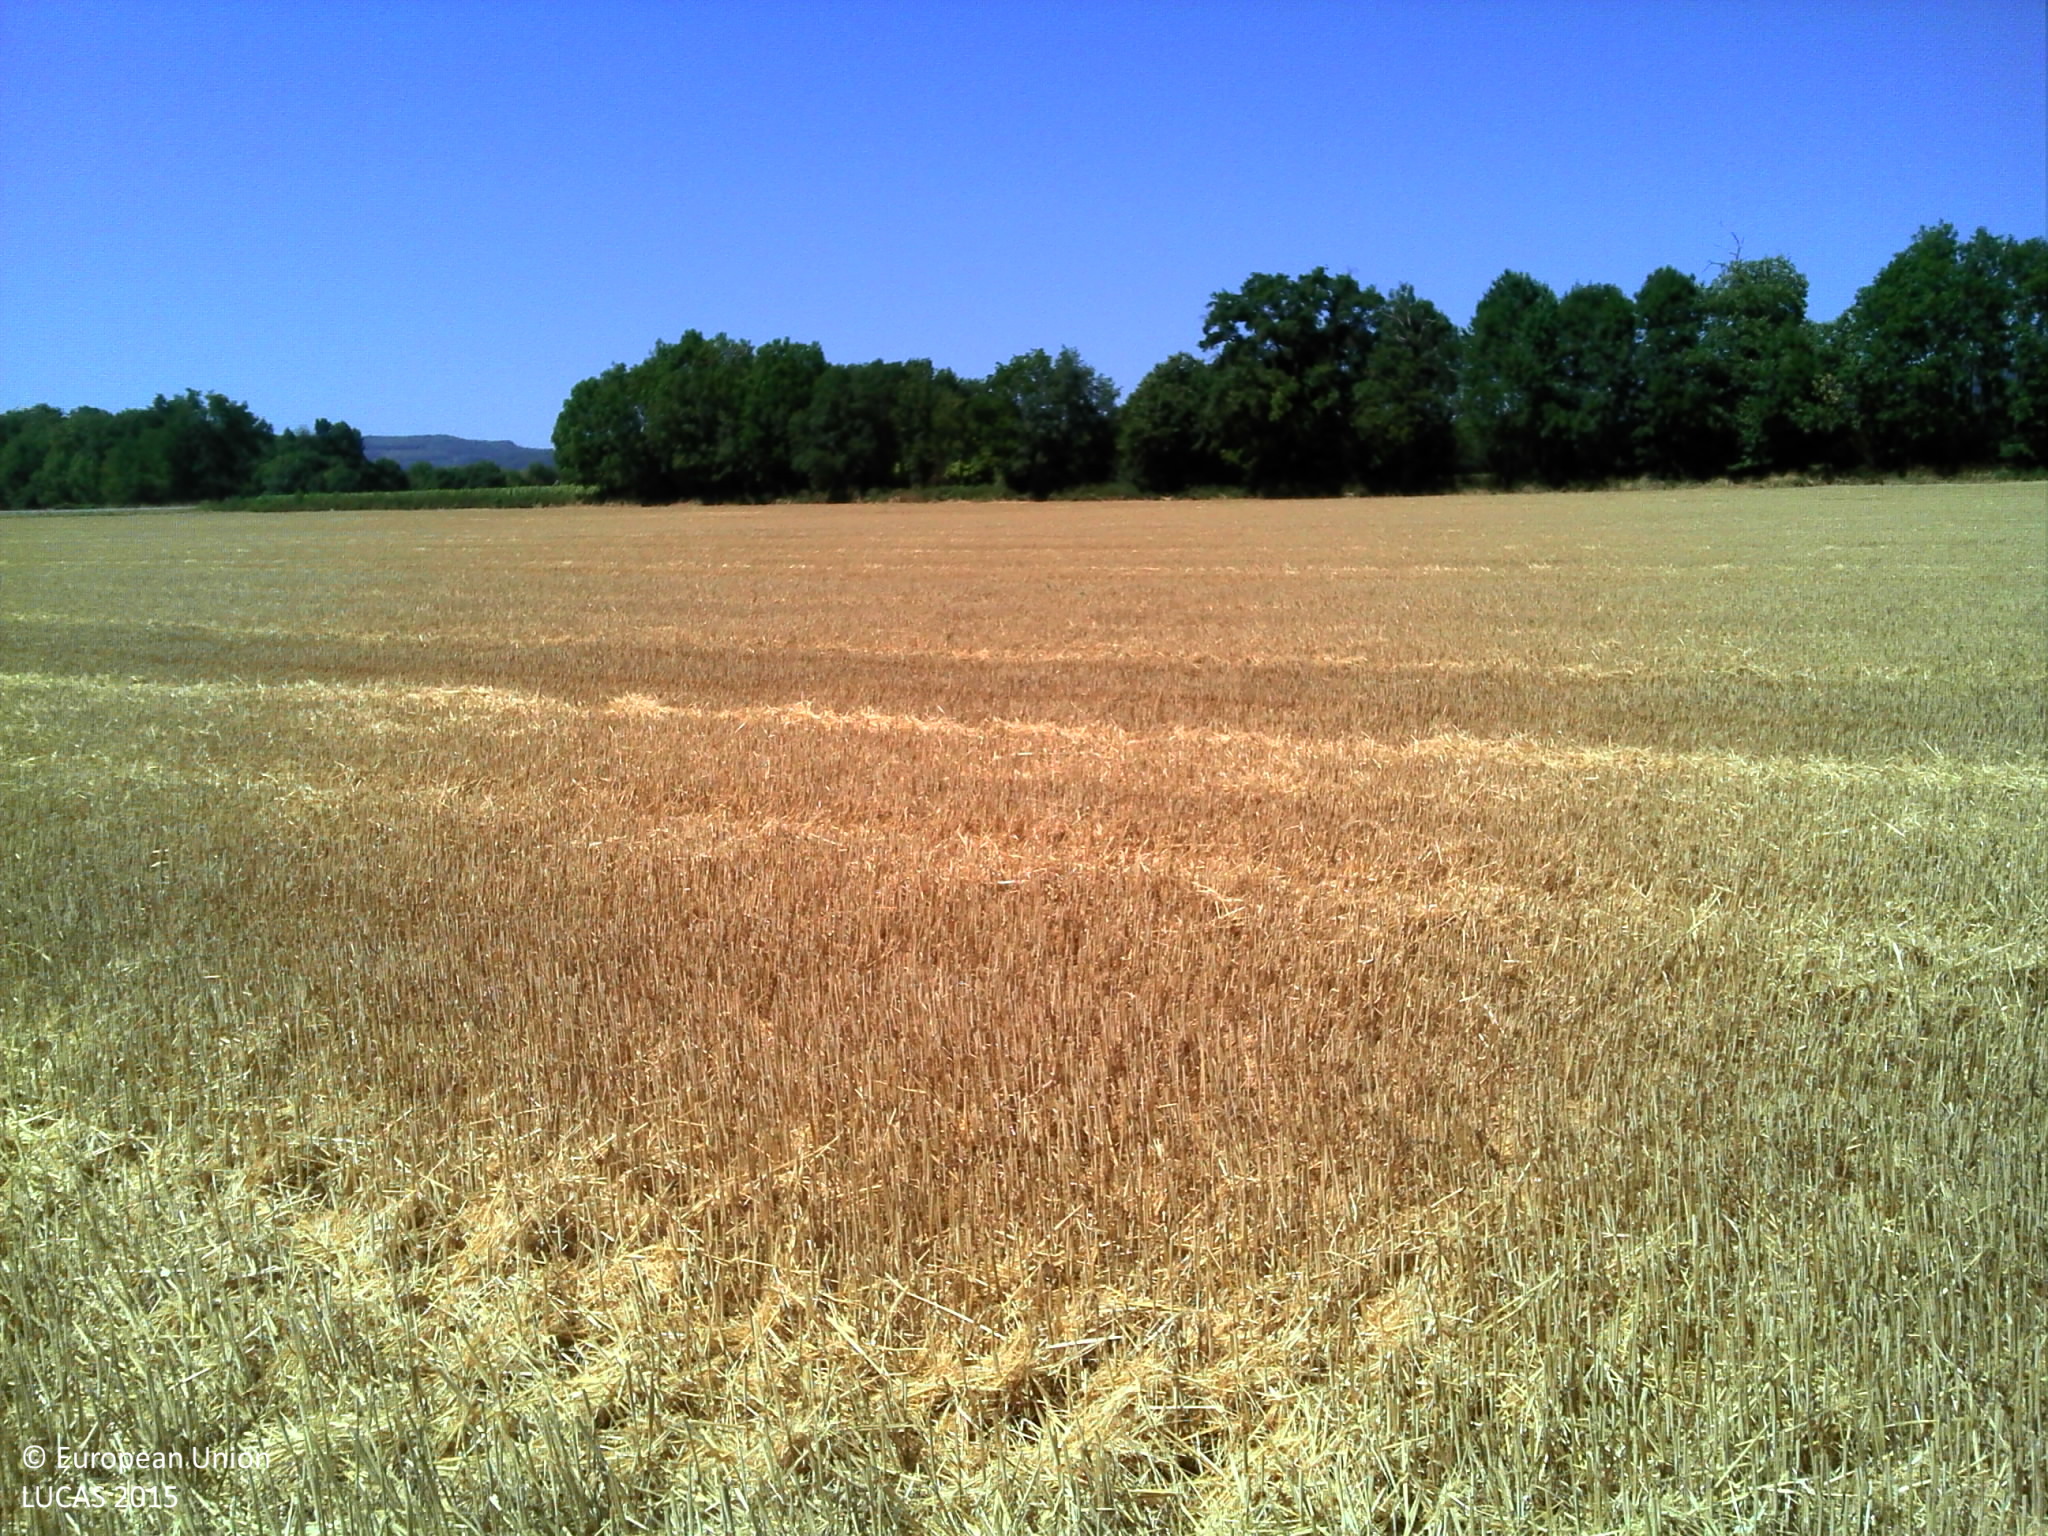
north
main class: Cropland
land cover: Durum wheat
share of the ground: > 75 %
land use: Agriculture (excluding fallow land and kitchen gardens)
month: July
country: FR
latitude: 45.3532
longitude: 5.4736
